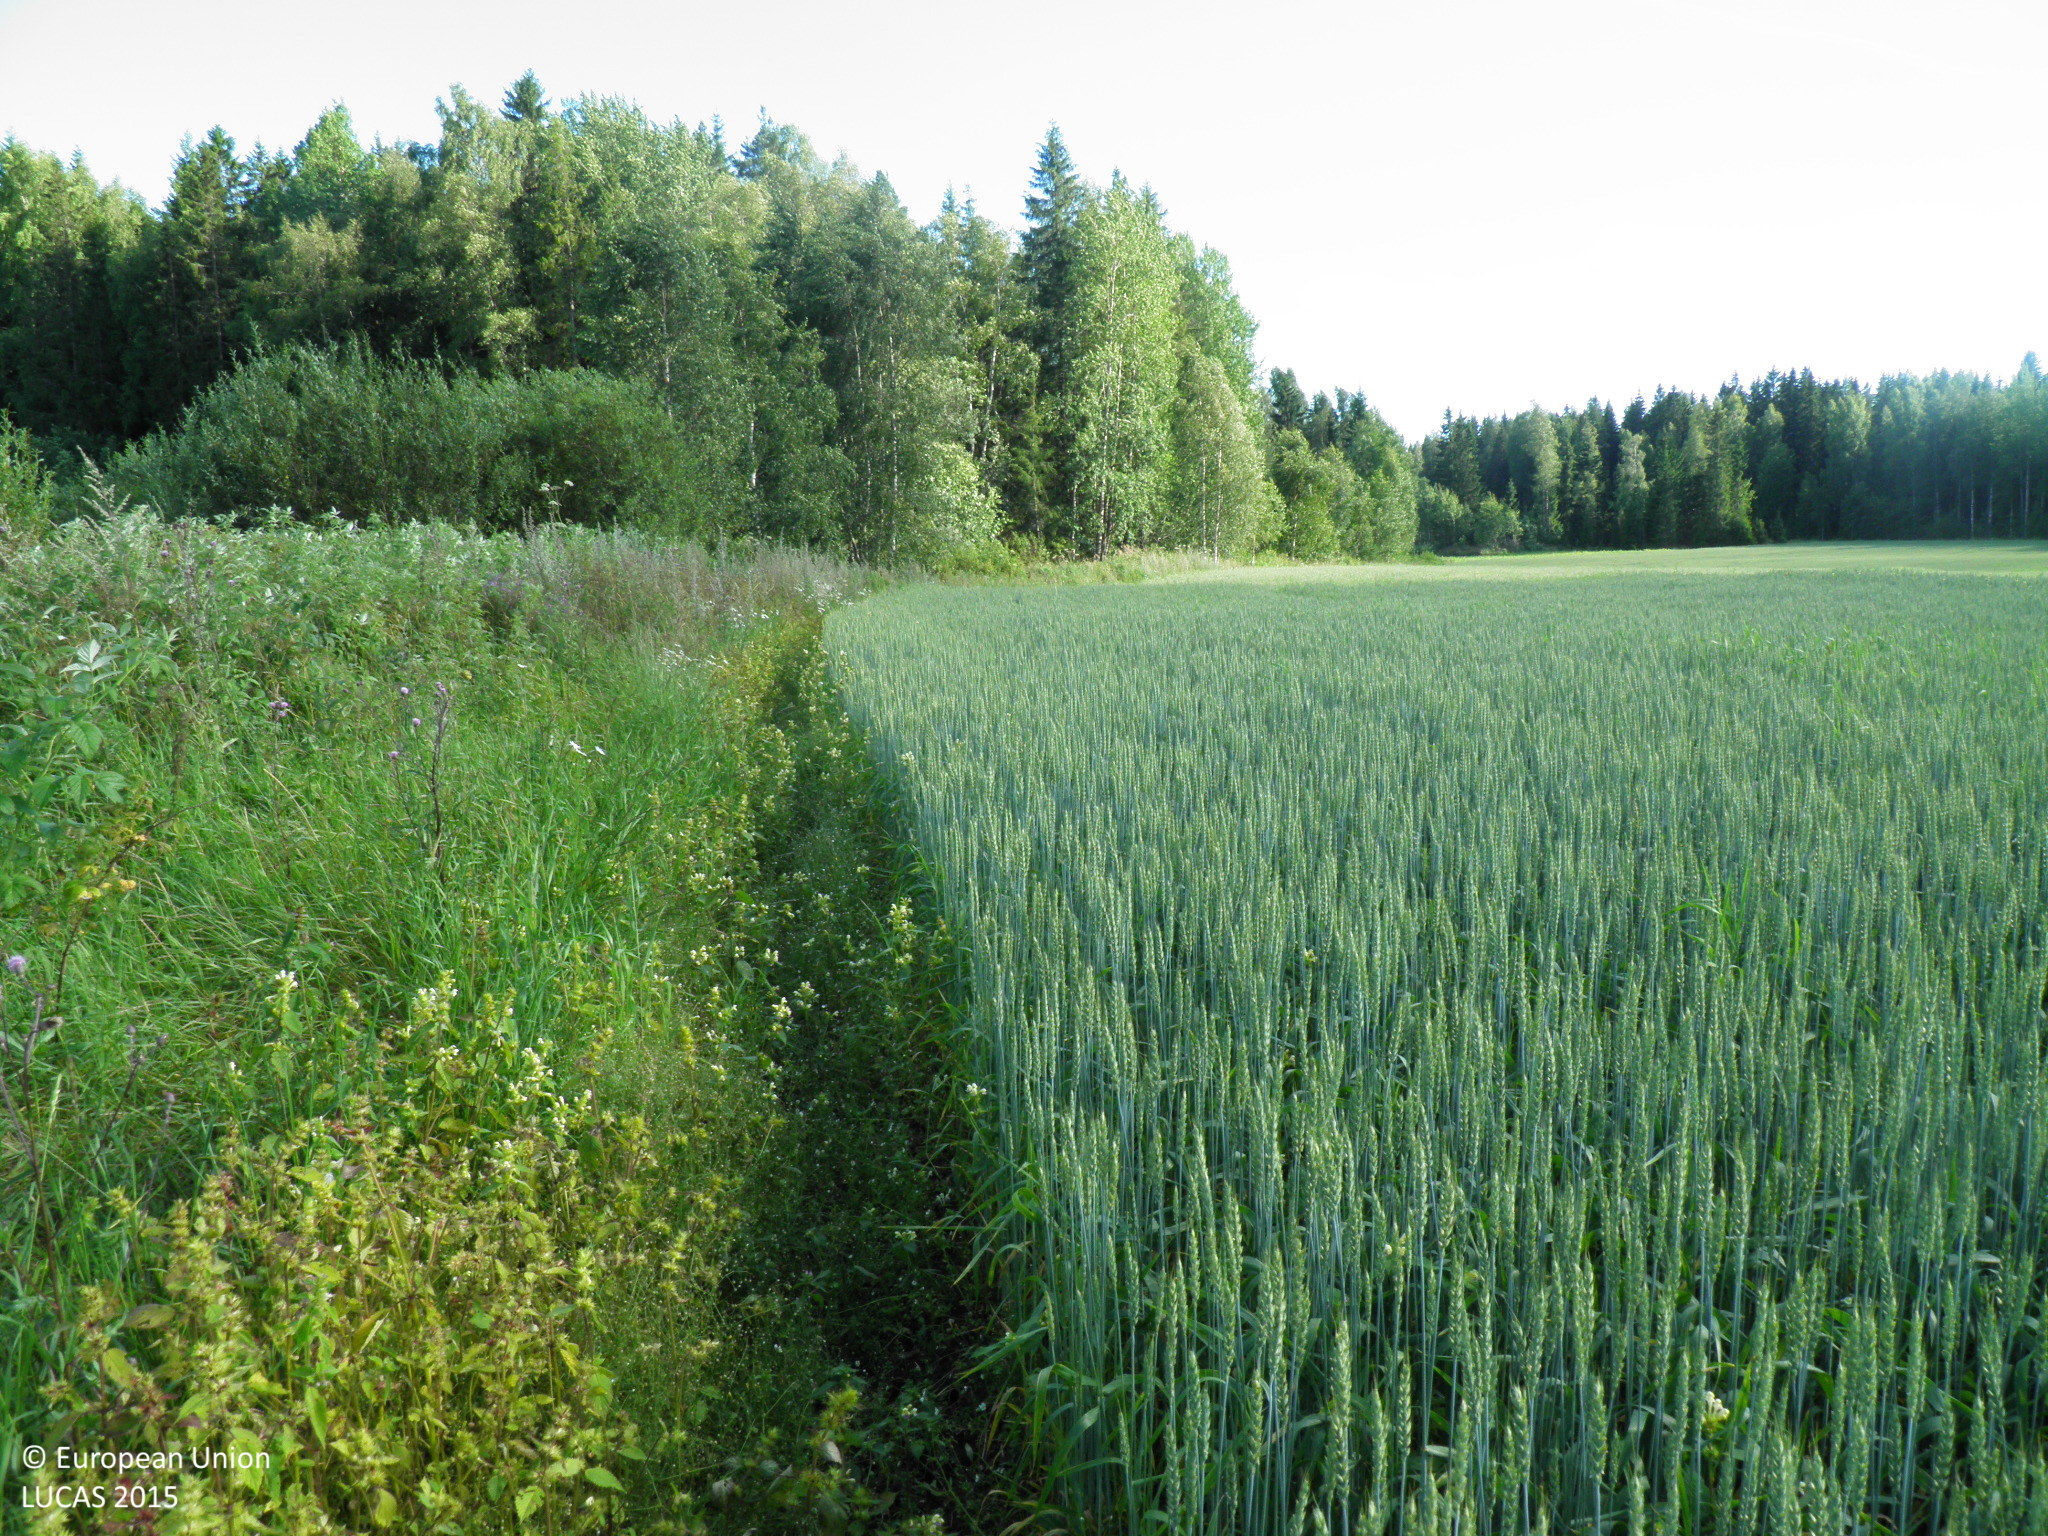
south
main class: Cropland
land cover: Common wheat
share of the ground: > 75 %
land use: Agriculture (excluding fallow land and kitchen gardens)
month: August
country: FI
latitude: 61.0022
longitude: 23.0006
